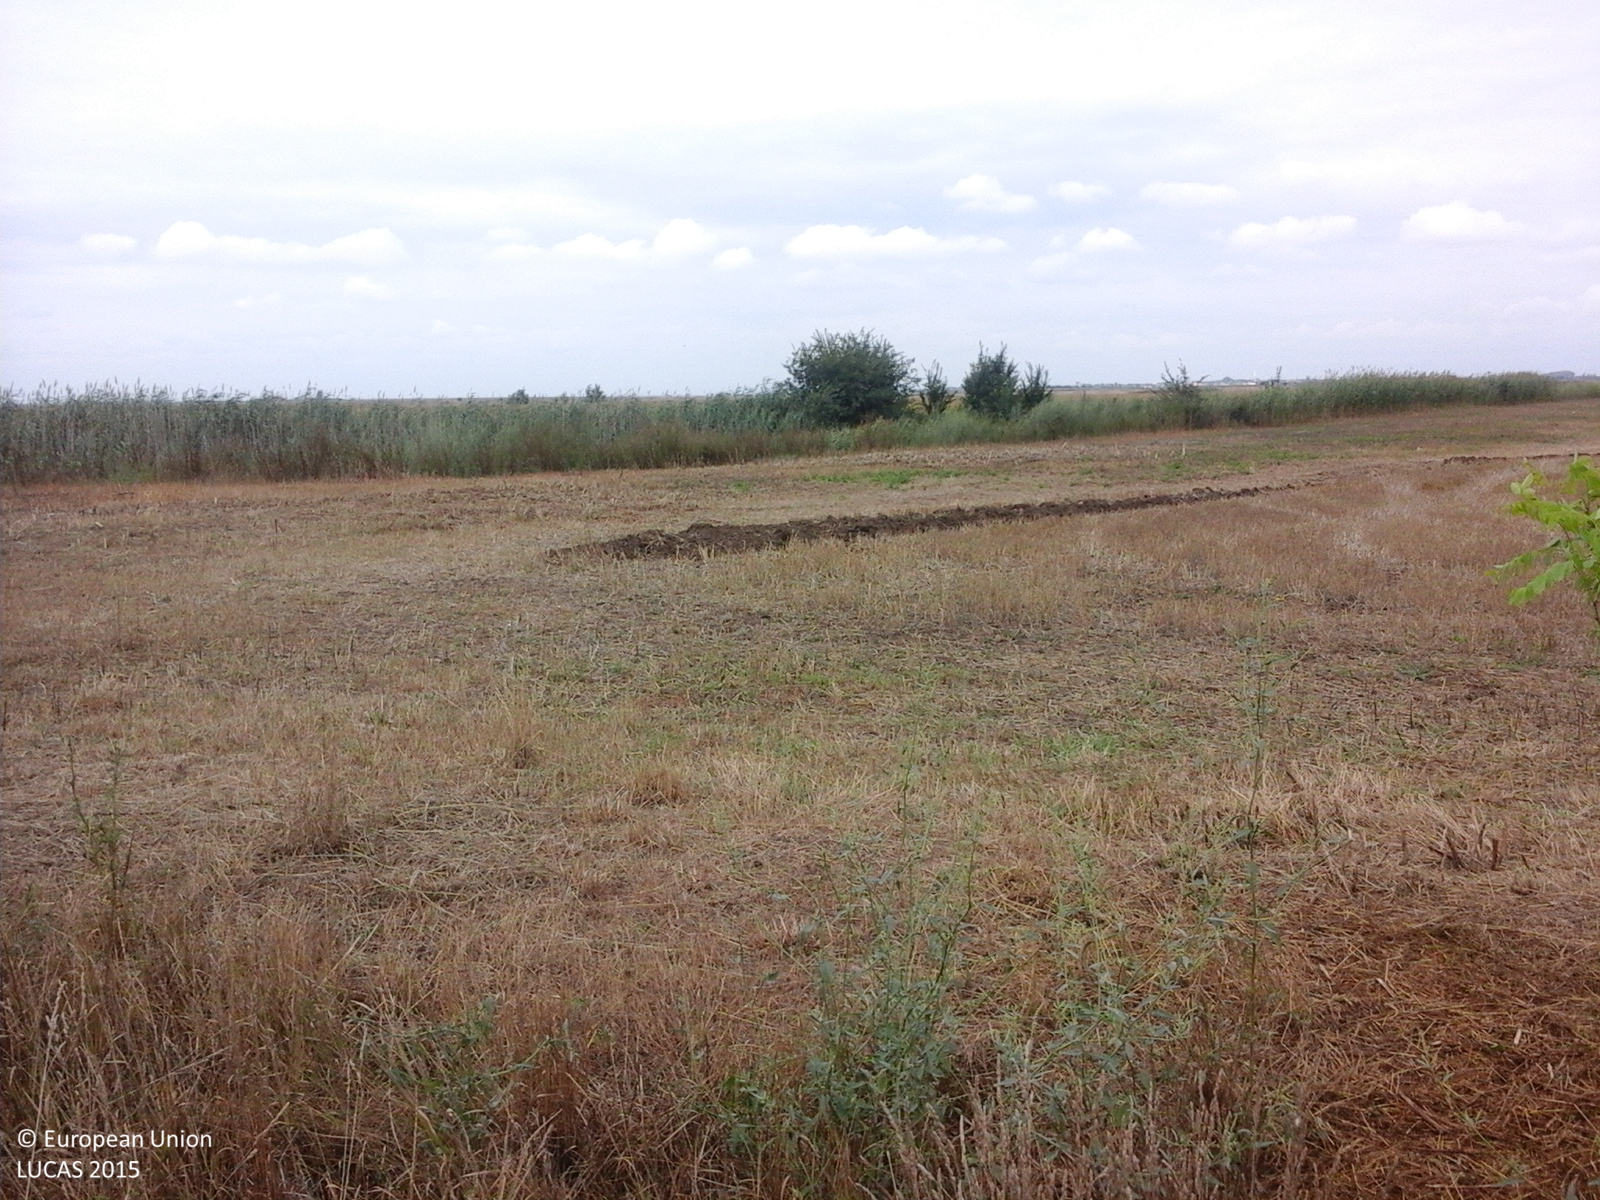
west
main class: Cropland
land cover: Maize
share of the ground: > 75 %
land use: Agriculture (excluding fallow land and kitchen gardens)
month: August
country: RO
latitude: 45.7854
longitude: 20.7921
